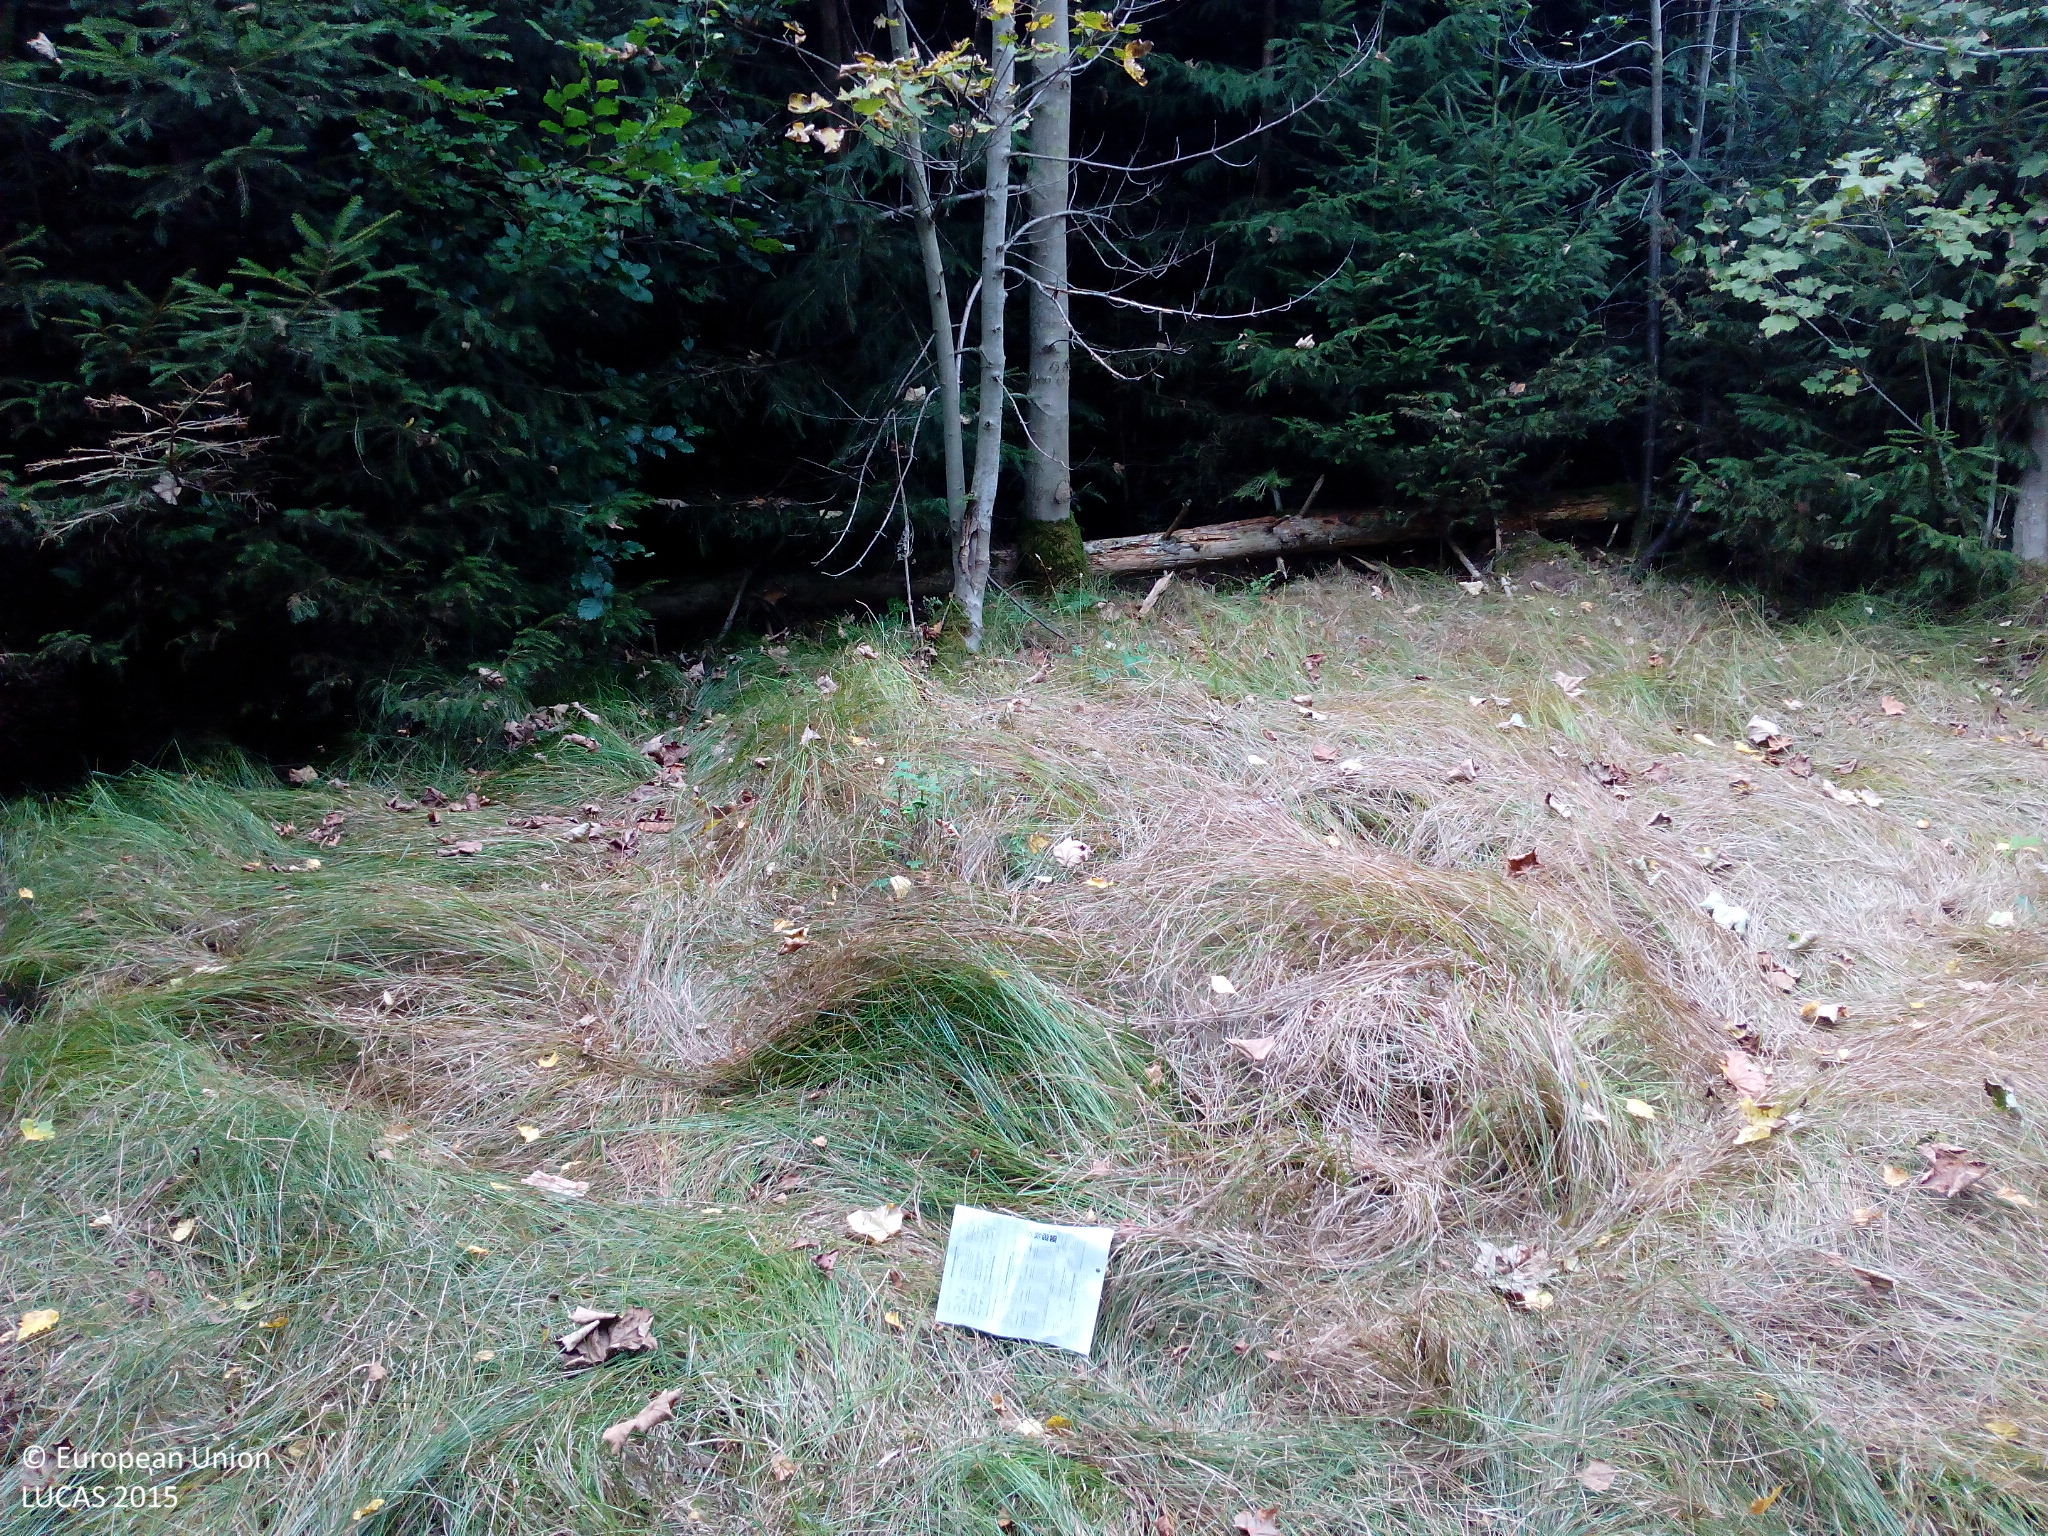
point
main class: Woodland
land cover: Broadleaved woodland
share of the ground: 50 - 75 %
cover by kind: broadleaved forest trees 60 %, herbaceous plants 40 %
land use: Forestry
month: September
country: DE
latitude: 48.3312
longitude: 10.2561
